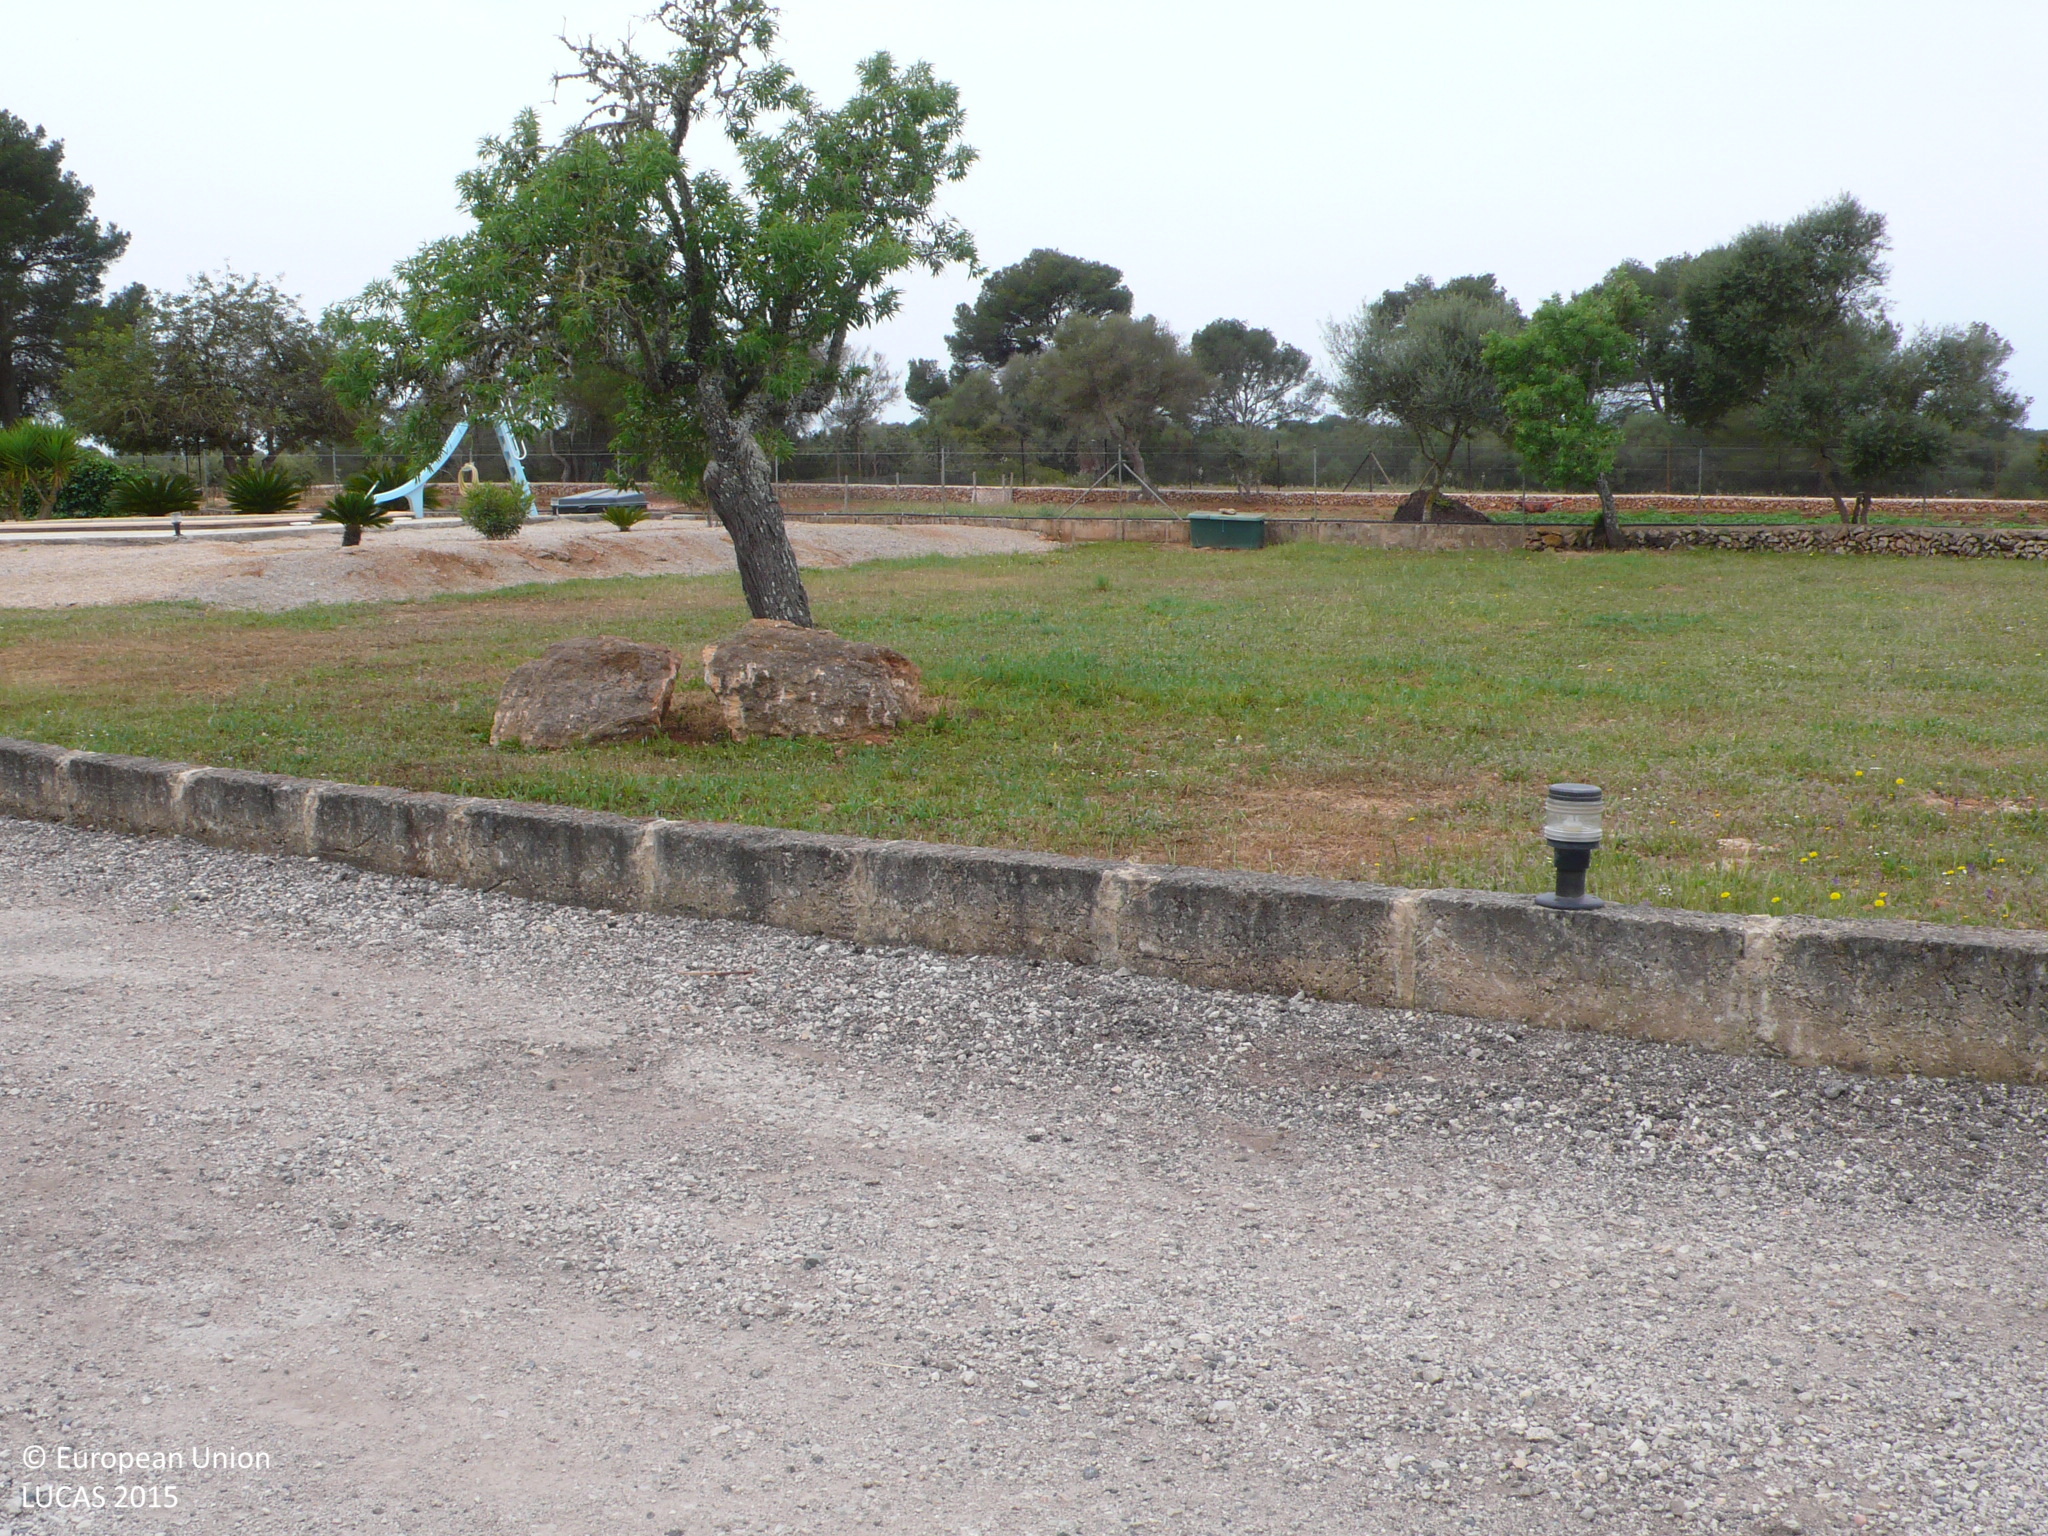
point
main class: Grassland
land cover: Grassland with sparse tree/shrub cover
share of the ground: > 75 %
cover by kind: herbaceous plants 75 %, consolidated bare surface 20 %, broadleaved forest trees 5 %
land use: Residential
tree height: < 5 m
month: April
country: ES
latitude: 39.5898
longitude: 2.8692
